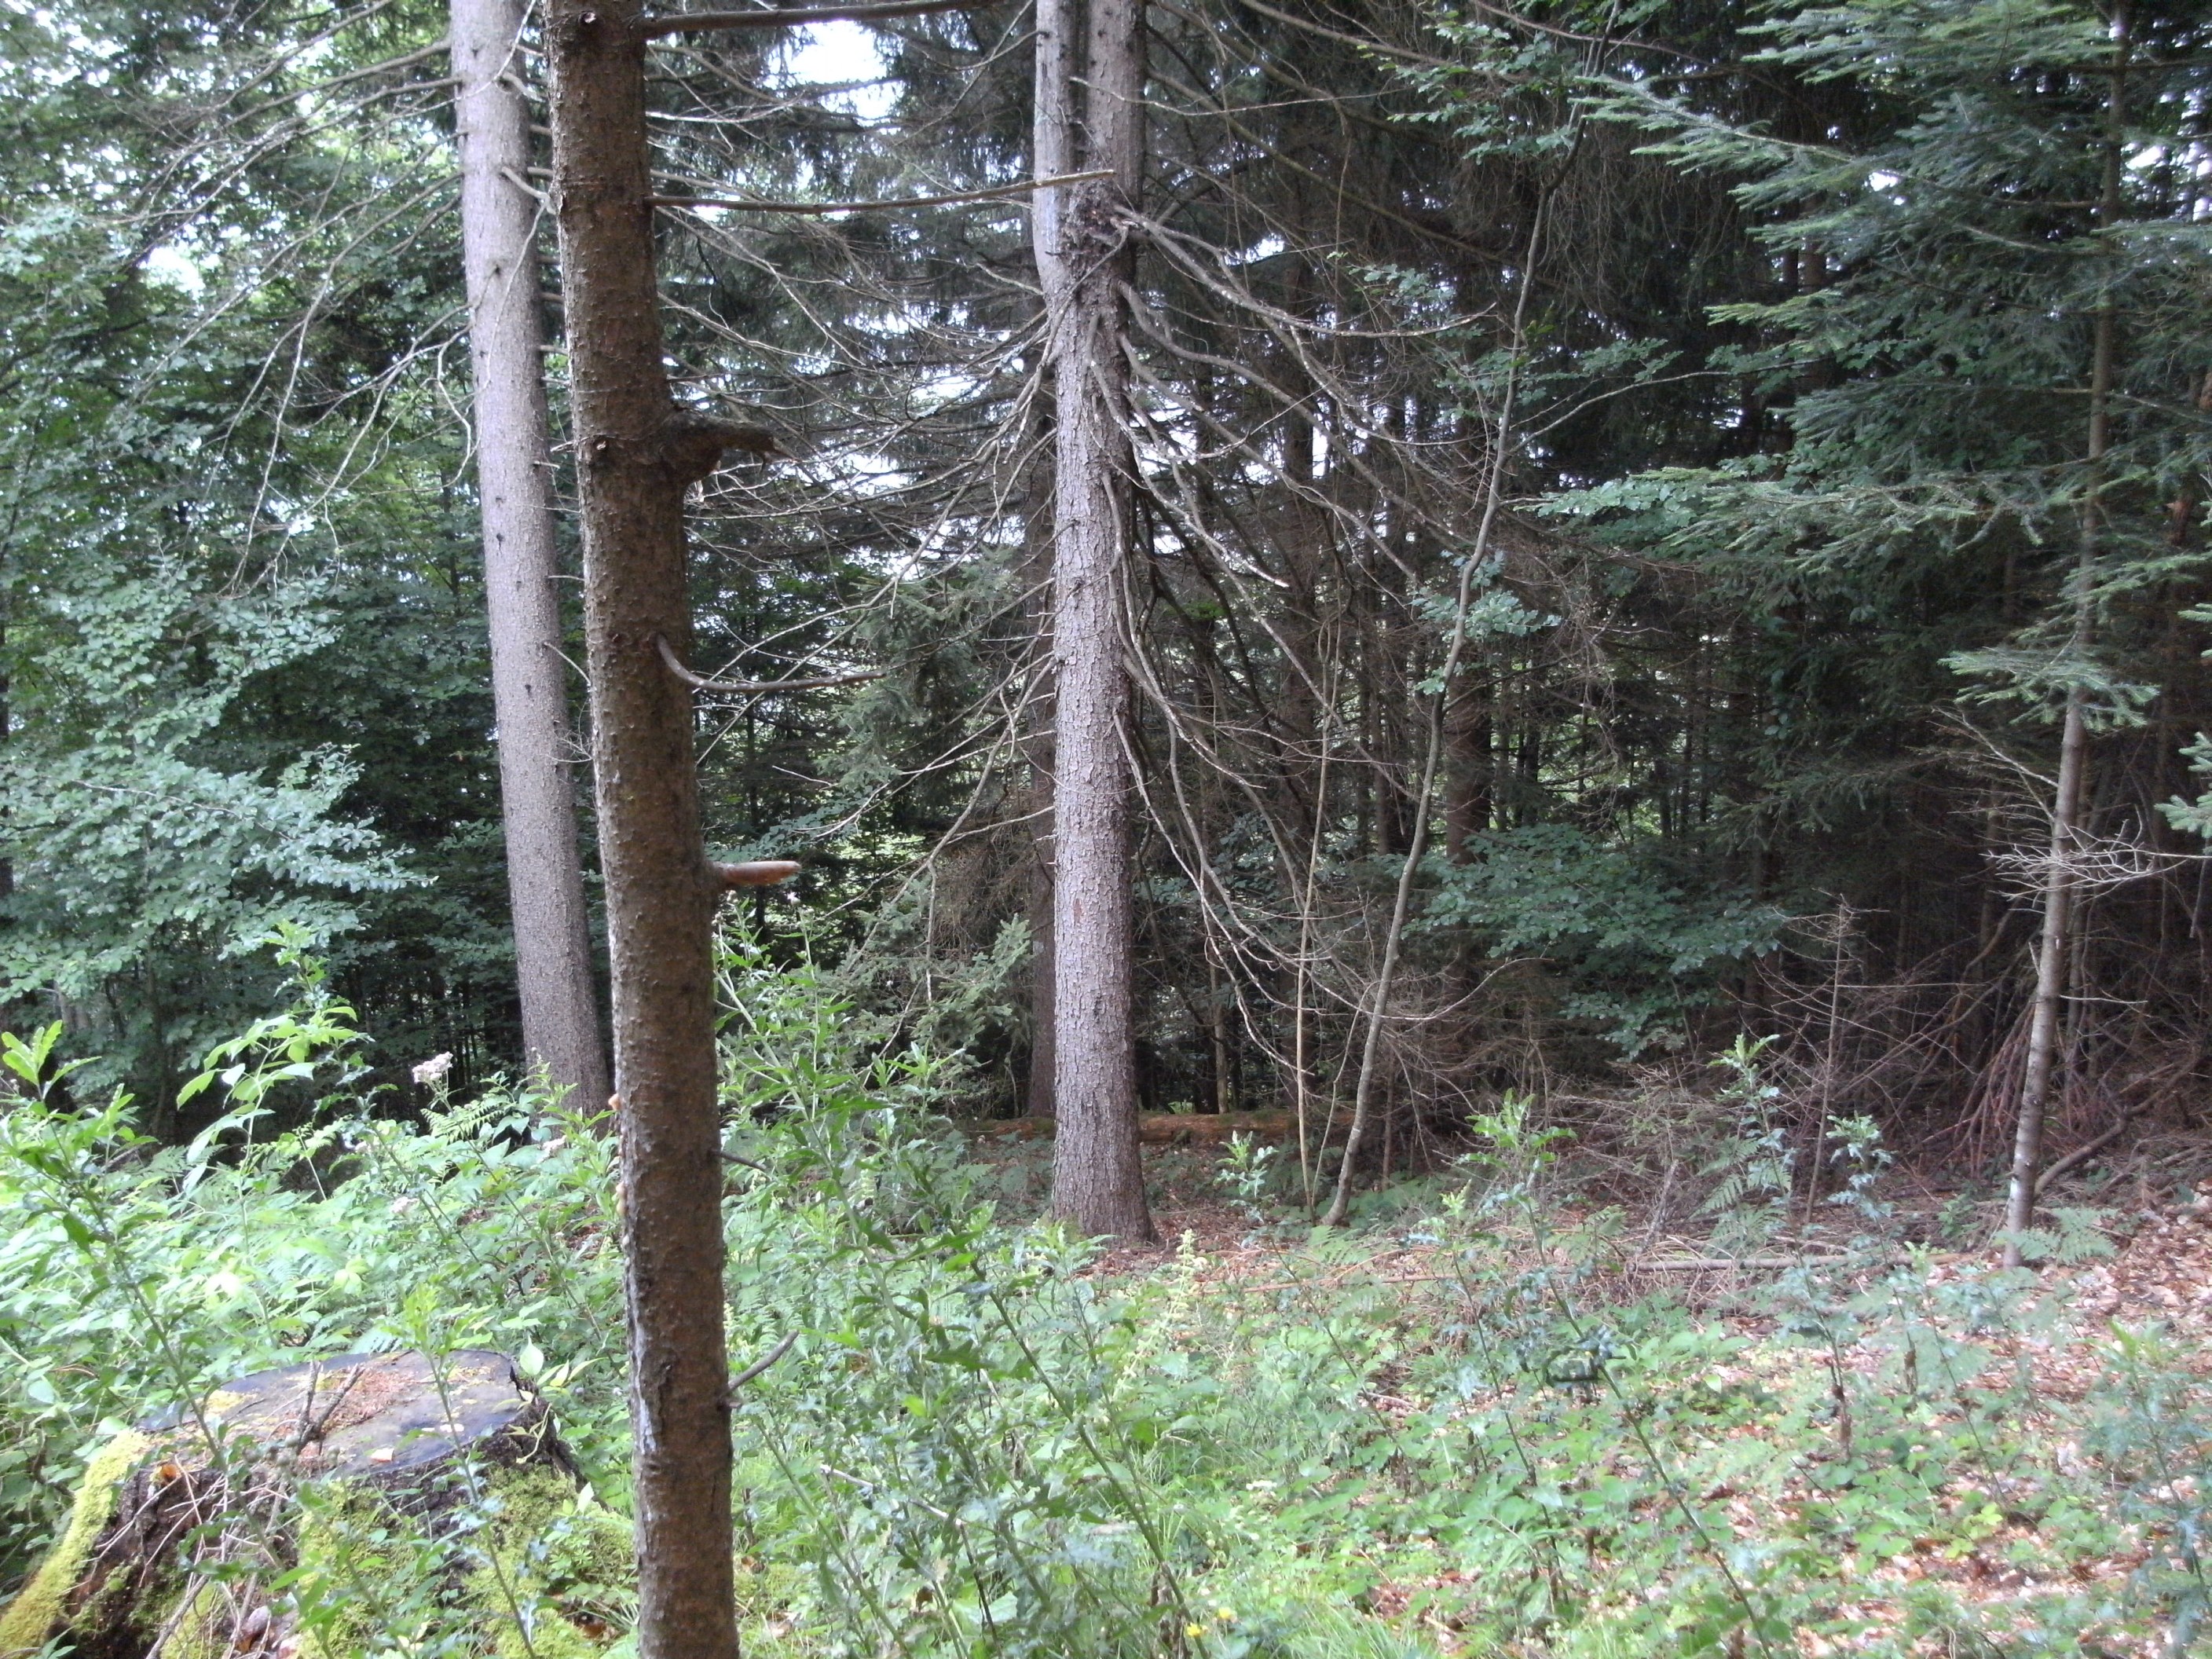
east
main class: Grassland
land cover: Spontaneously vegetated surfaces
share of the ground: > 75 %
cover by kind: herbaceous plants 100 %
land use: Forestry
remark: Clear cut
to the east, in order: Spontaneously vegetated surfaces; Spruce dominated coniferous woodland; Spruce dominated mixed woodland; Spruce dominated coniferous woodland; Tracks; Spruce dominated coniferous woodland; Tracks; Spruce dominated coniferous woodland; Tracks; Spruce dominated coniferous woodland
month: July
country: AT
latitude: 46.5295
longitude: 14.4431
